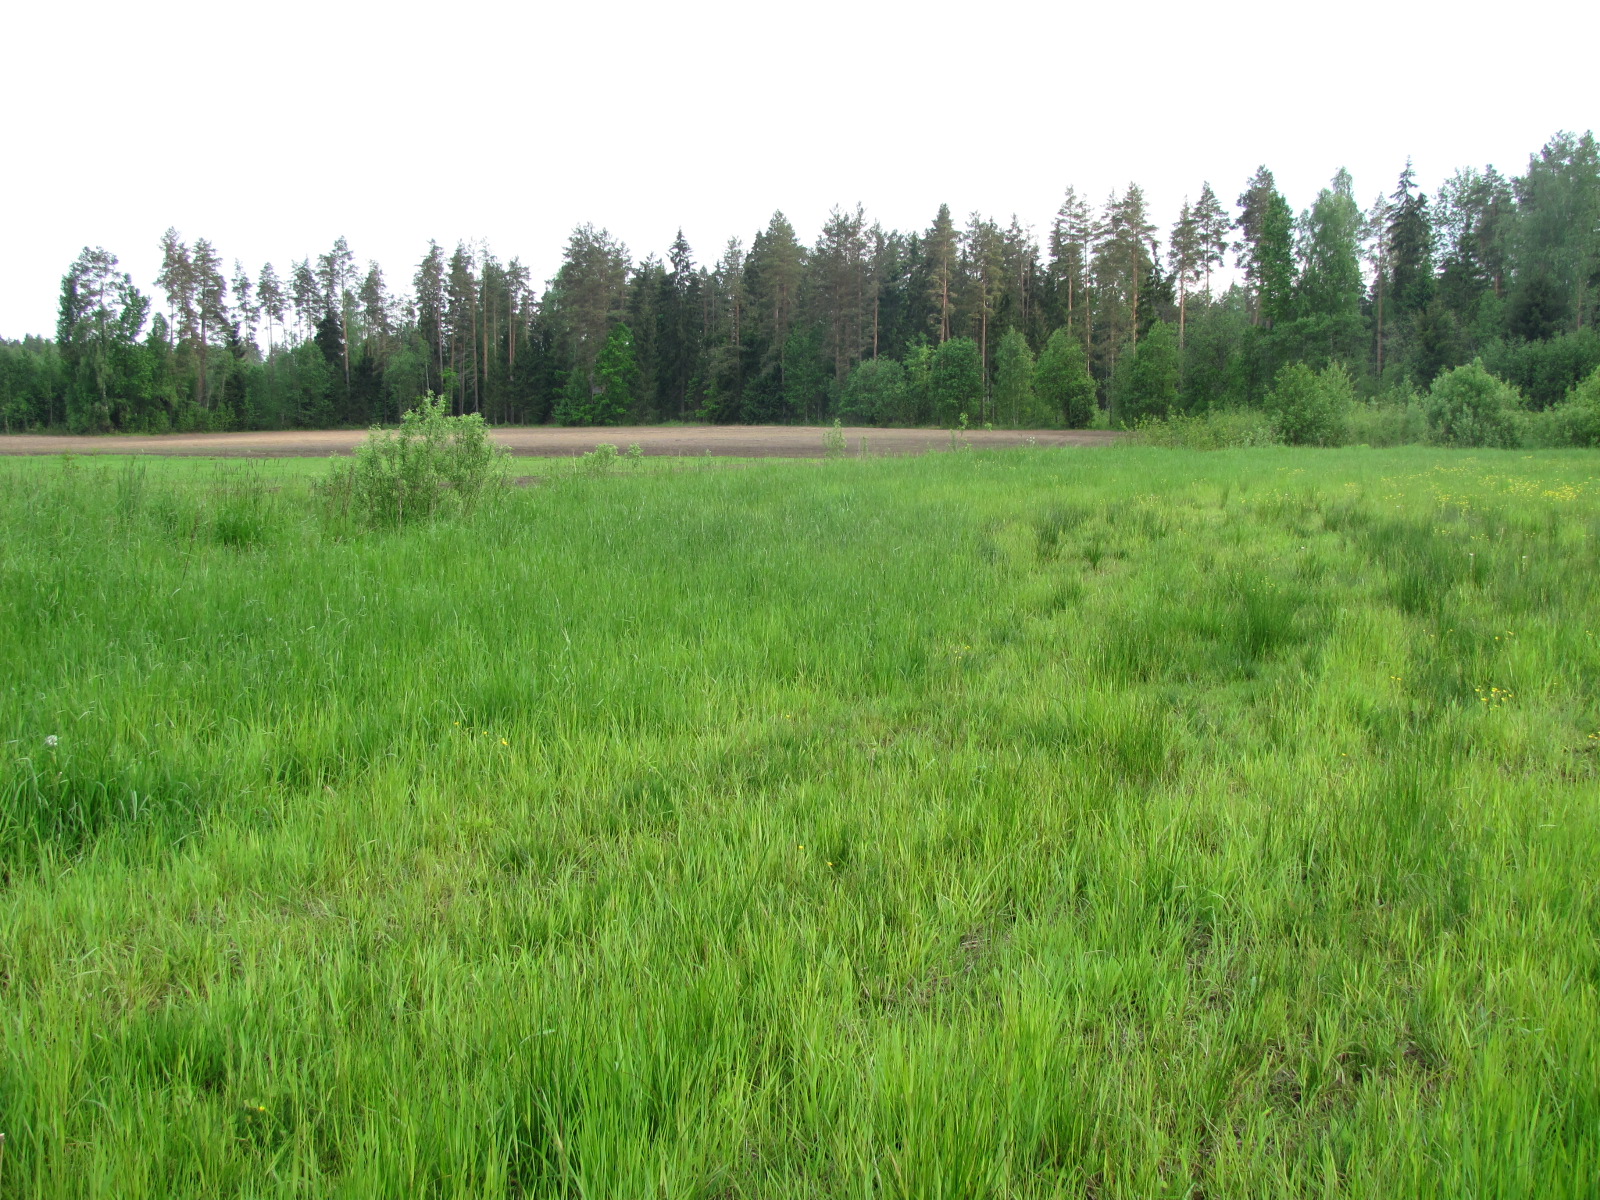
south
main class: Grassland
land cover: Grassland without tree/shrub cover
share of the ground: > 75 %
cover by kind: herbaceous plants 100 %
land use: Agriculture (excluding fallow land and kitchen gardens)
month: June
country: LV
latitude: 56.6793
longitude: 24.3078
